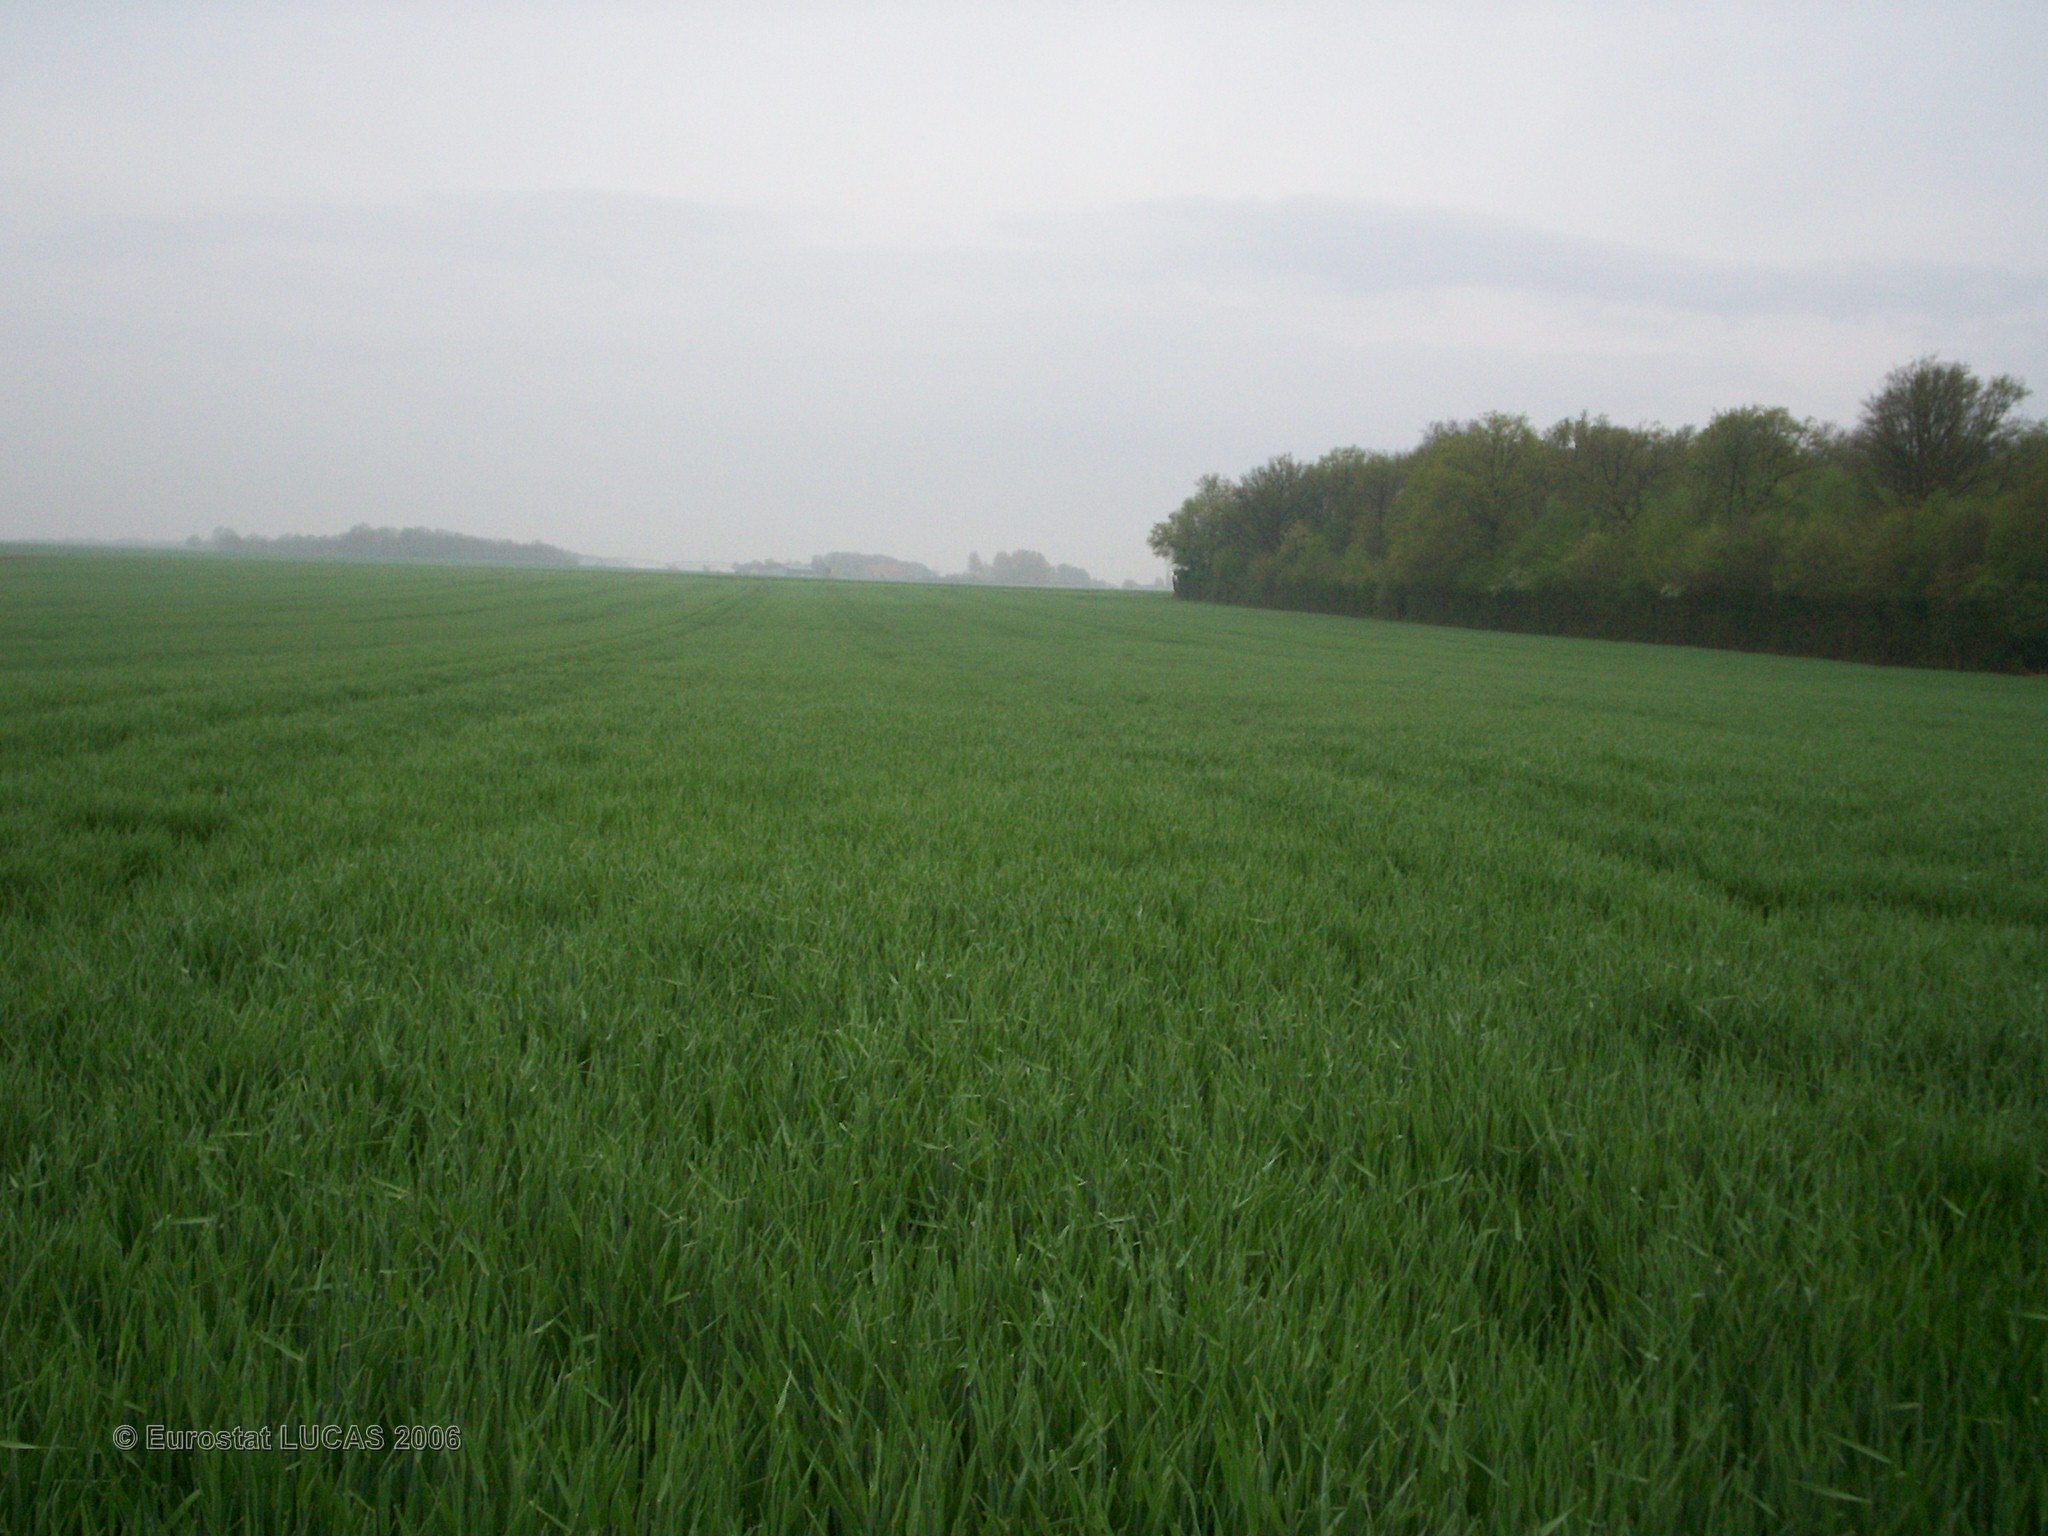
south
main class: Cropland
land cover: Barley
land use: Agriculture (excluding fallow land and kitchen gardens)
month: April
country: FR
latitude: 47.8856
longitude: 2.8916
